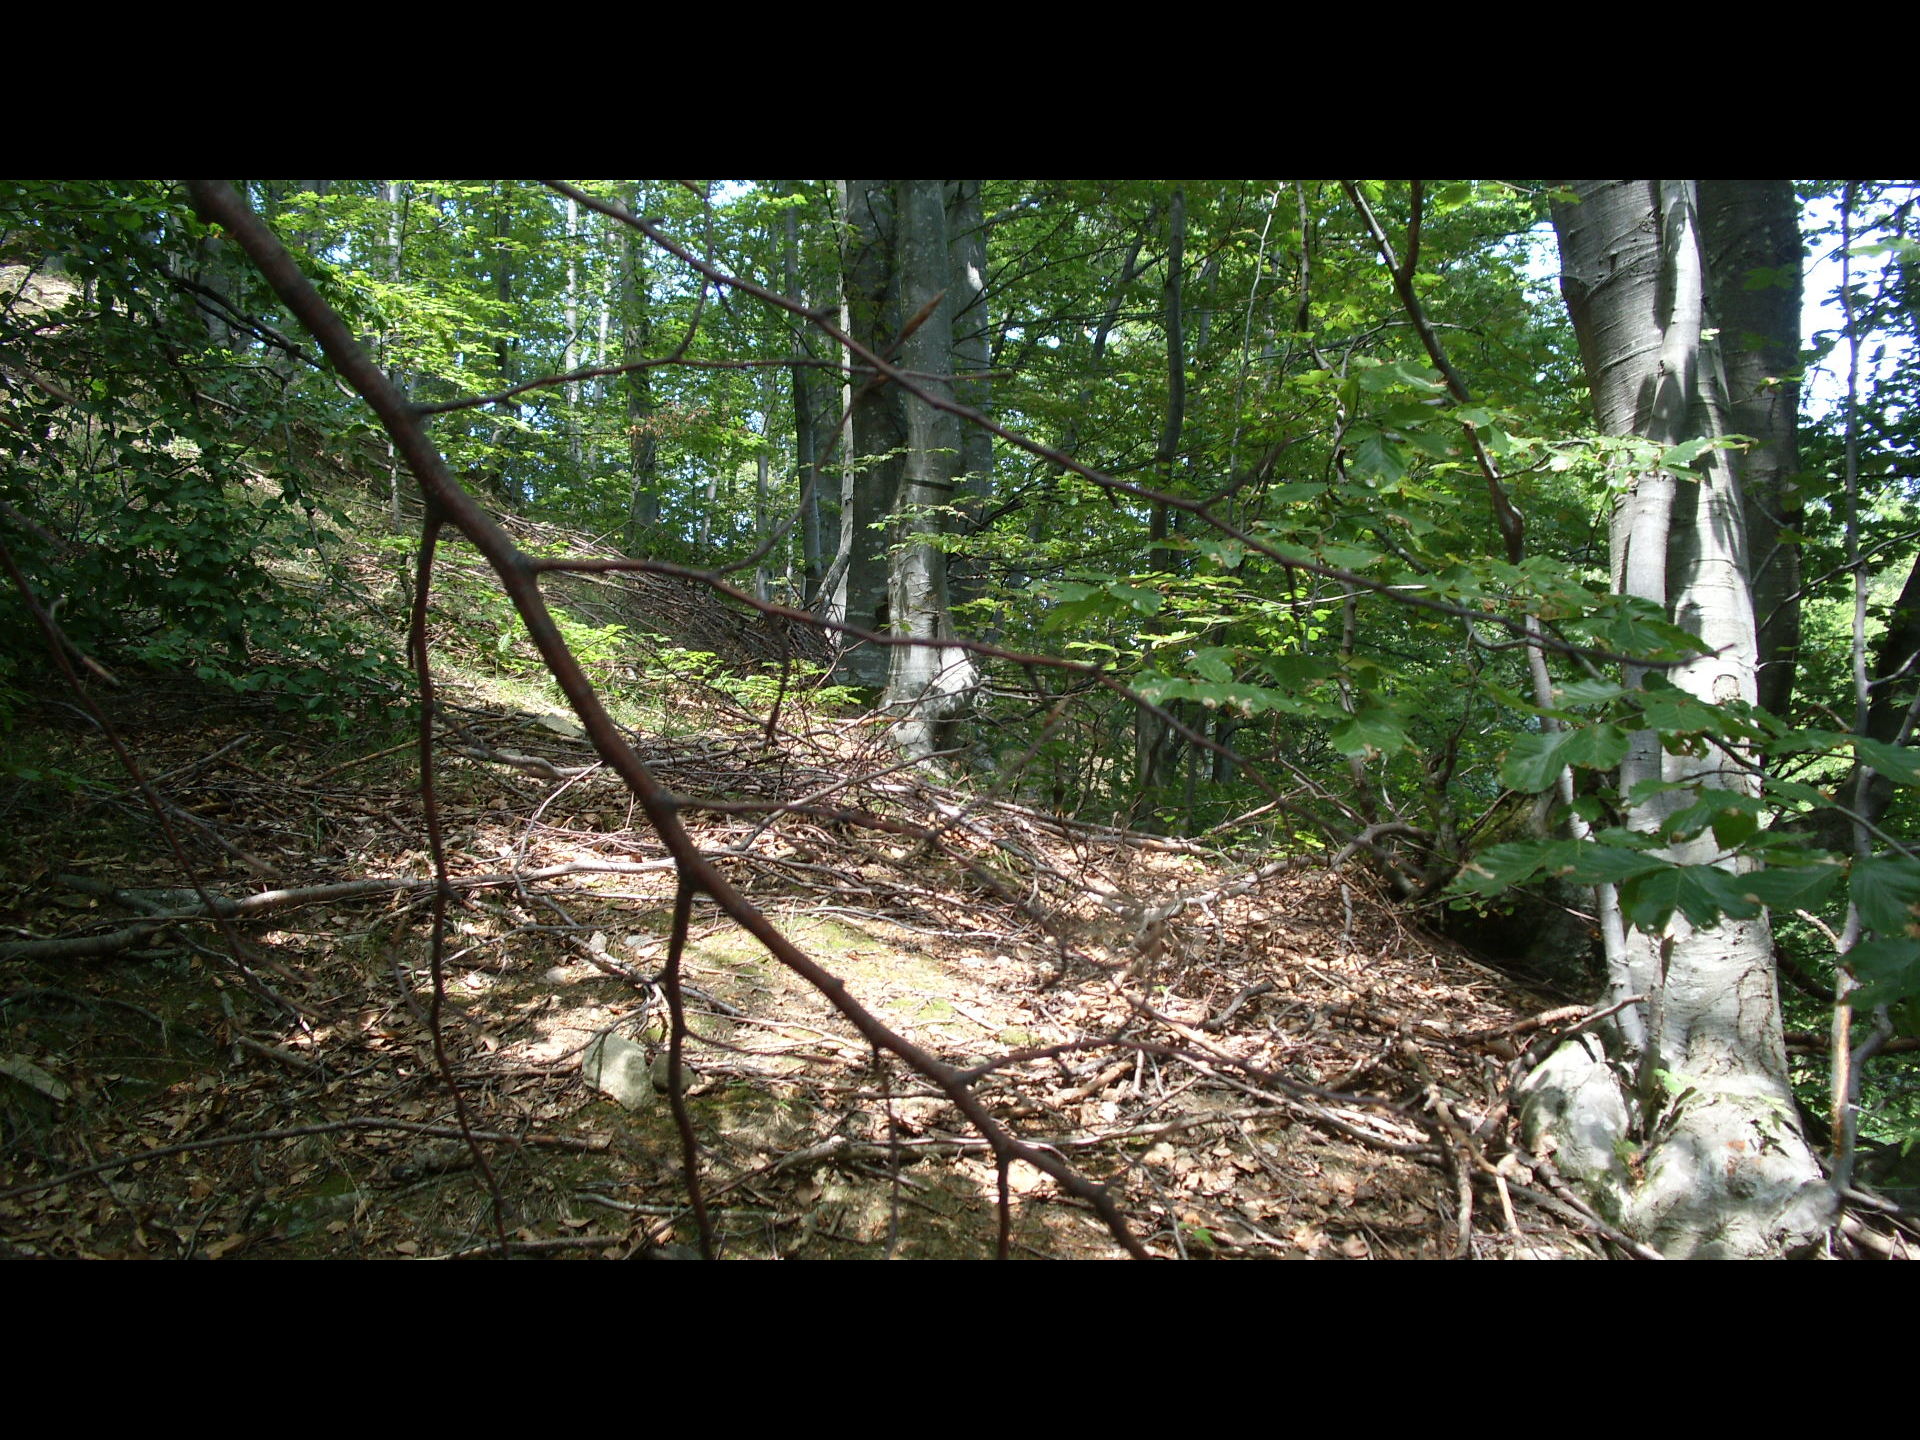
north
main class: Woodland
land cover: Broadleaved woodland
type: beech forest
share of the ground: > 75 %
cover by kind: broadleaved forest trees 90 %, shrubs 5 %, herbaceous plants 5 %
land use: Forestry
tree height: > 5 m
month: August
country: BG
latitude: 43.1520
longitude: 23.2321
